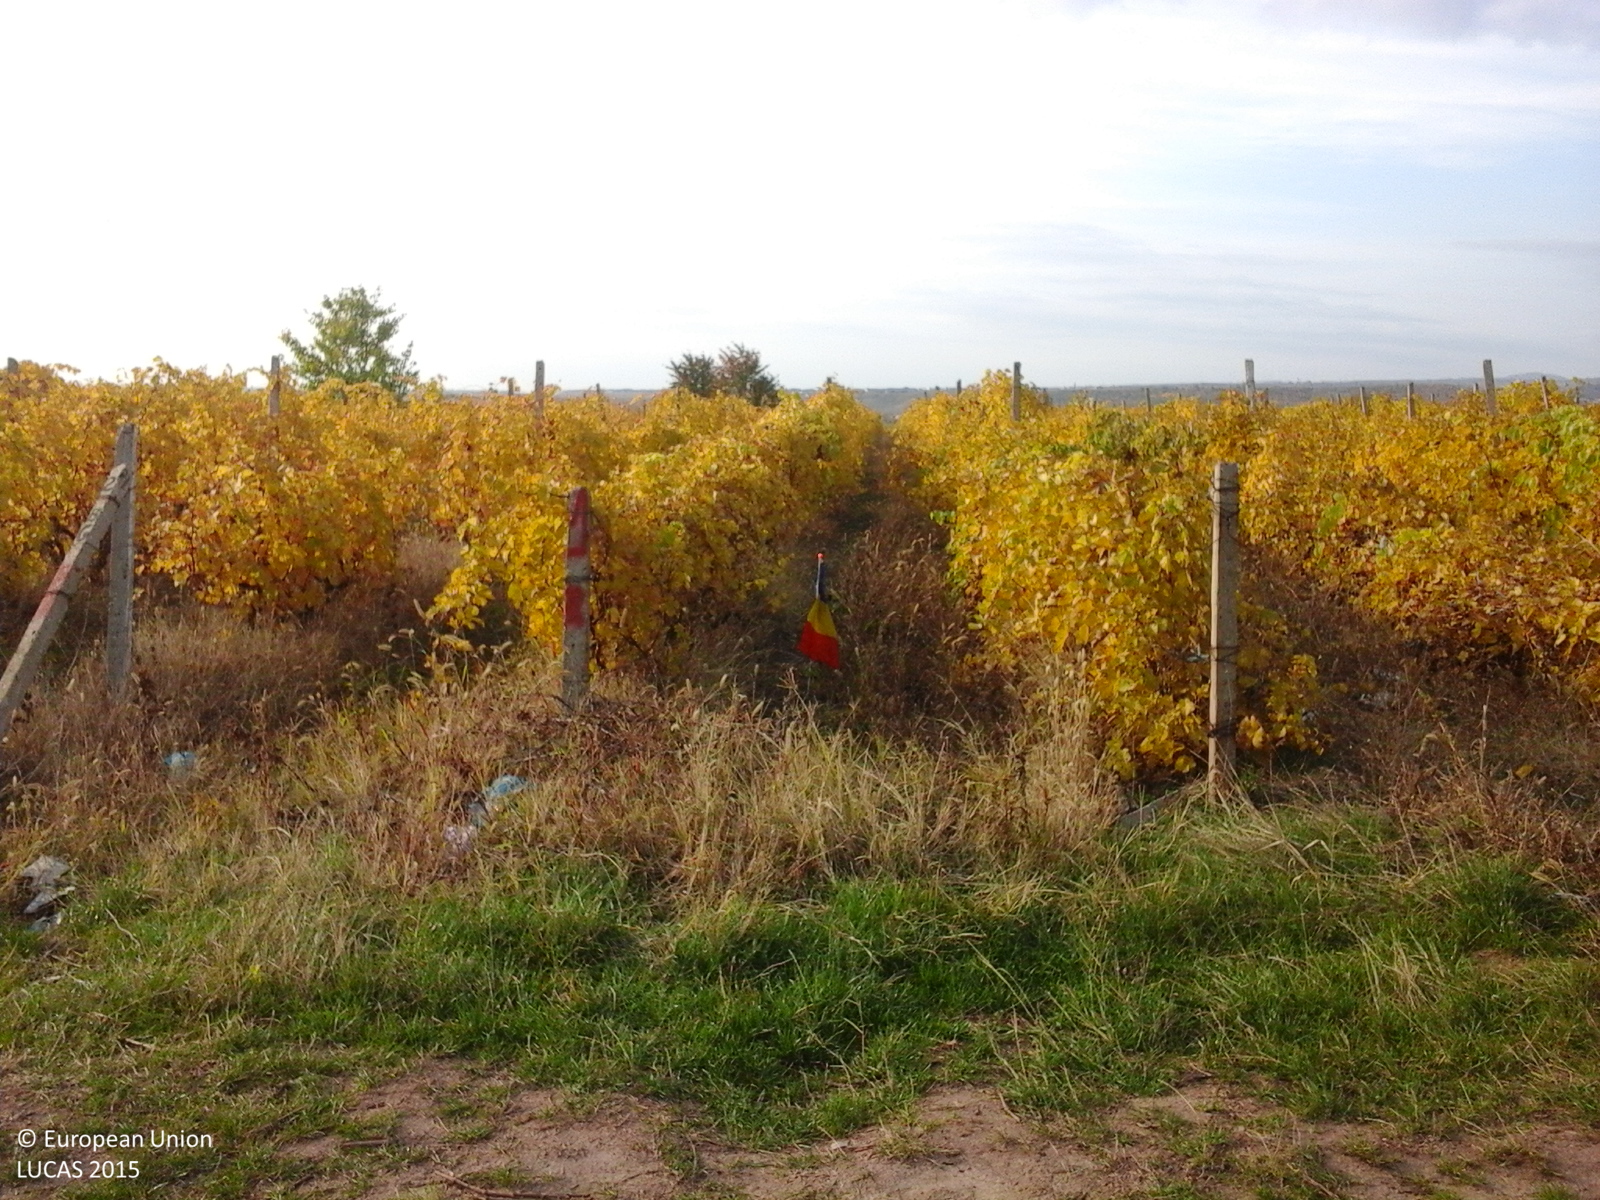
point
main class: Cropland
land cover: Vineyards
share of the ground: > 75 %
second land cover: Grassland without tree/shrub cover
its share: > 75 %
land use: Agriculture (excluding fallow land and kitchen gardens)
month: October
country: RO
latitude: 45.5166
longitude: 27.0777
